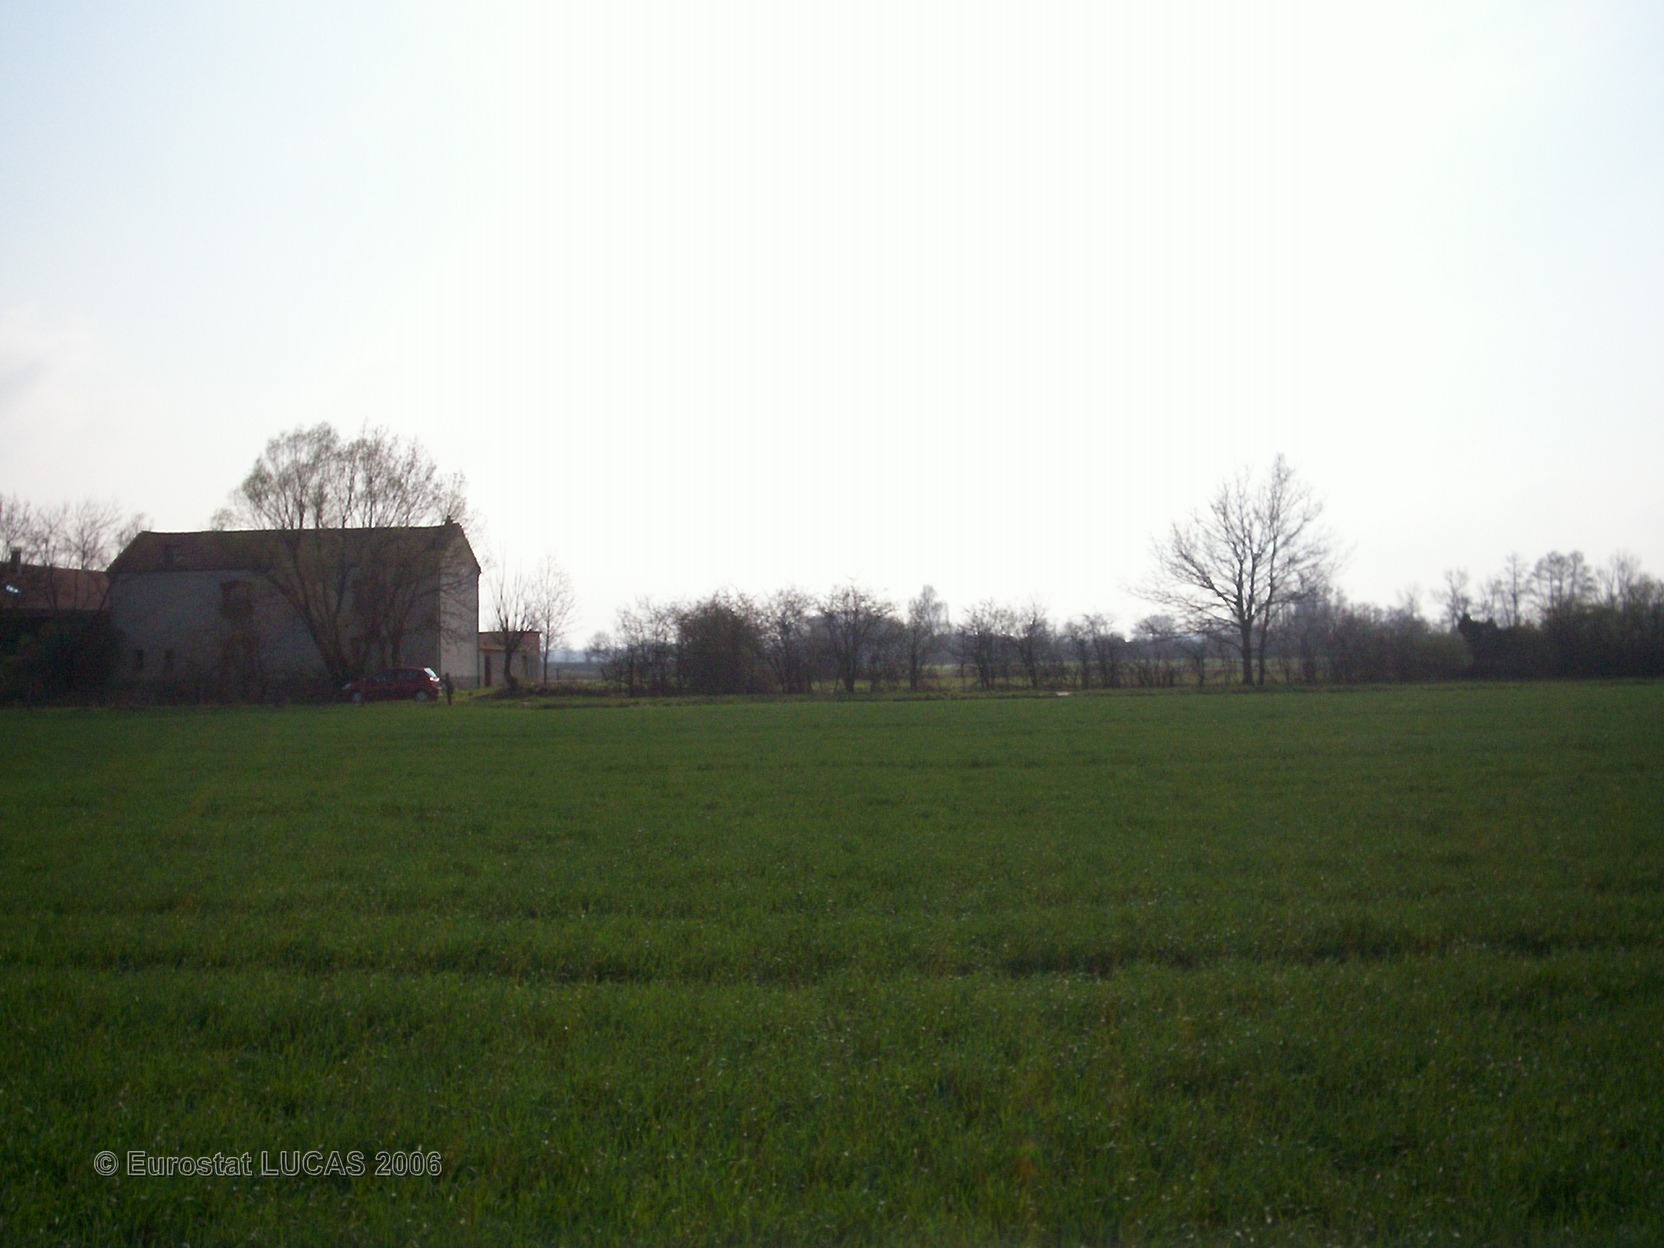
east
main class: Cropland
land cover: Common wheat
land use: Agriculture (excluding fallow land and kitchen gardens)
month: April
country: FR
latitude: 45.5768
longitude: 4.1465
